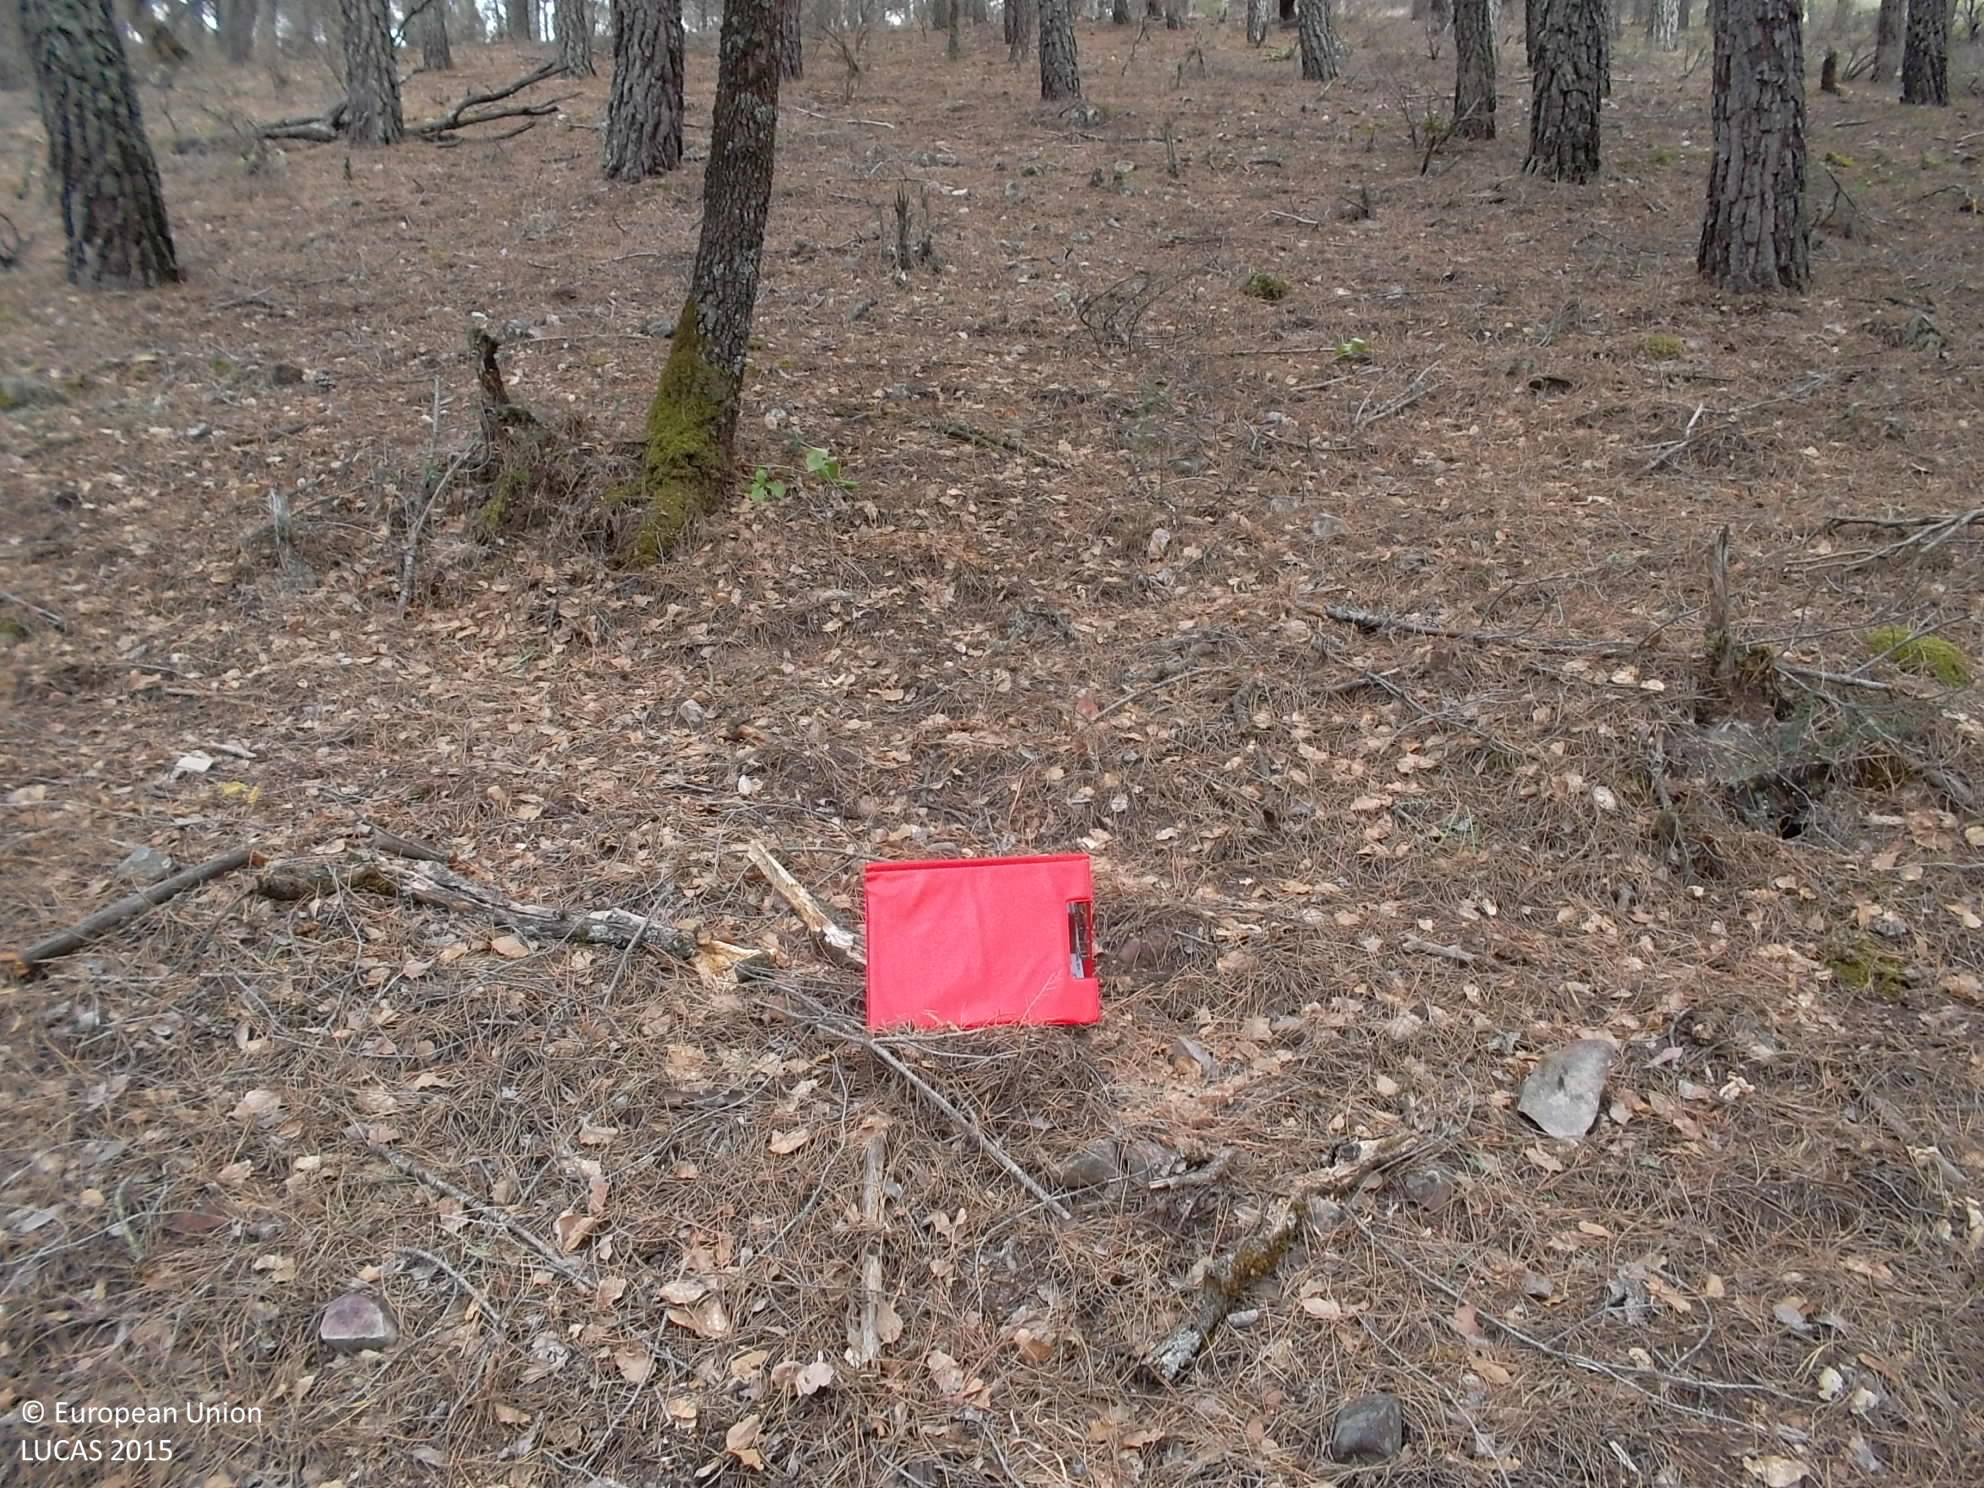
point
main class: Woodland
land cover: Pine dominated coniferous woodland
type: alpine coniferous forest
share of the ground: > 75 %
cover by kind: coniferous forest trees 100 %
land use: Forestry
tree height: > 5 m
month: June
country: ES
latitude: 39.0008
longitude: -4.4964
